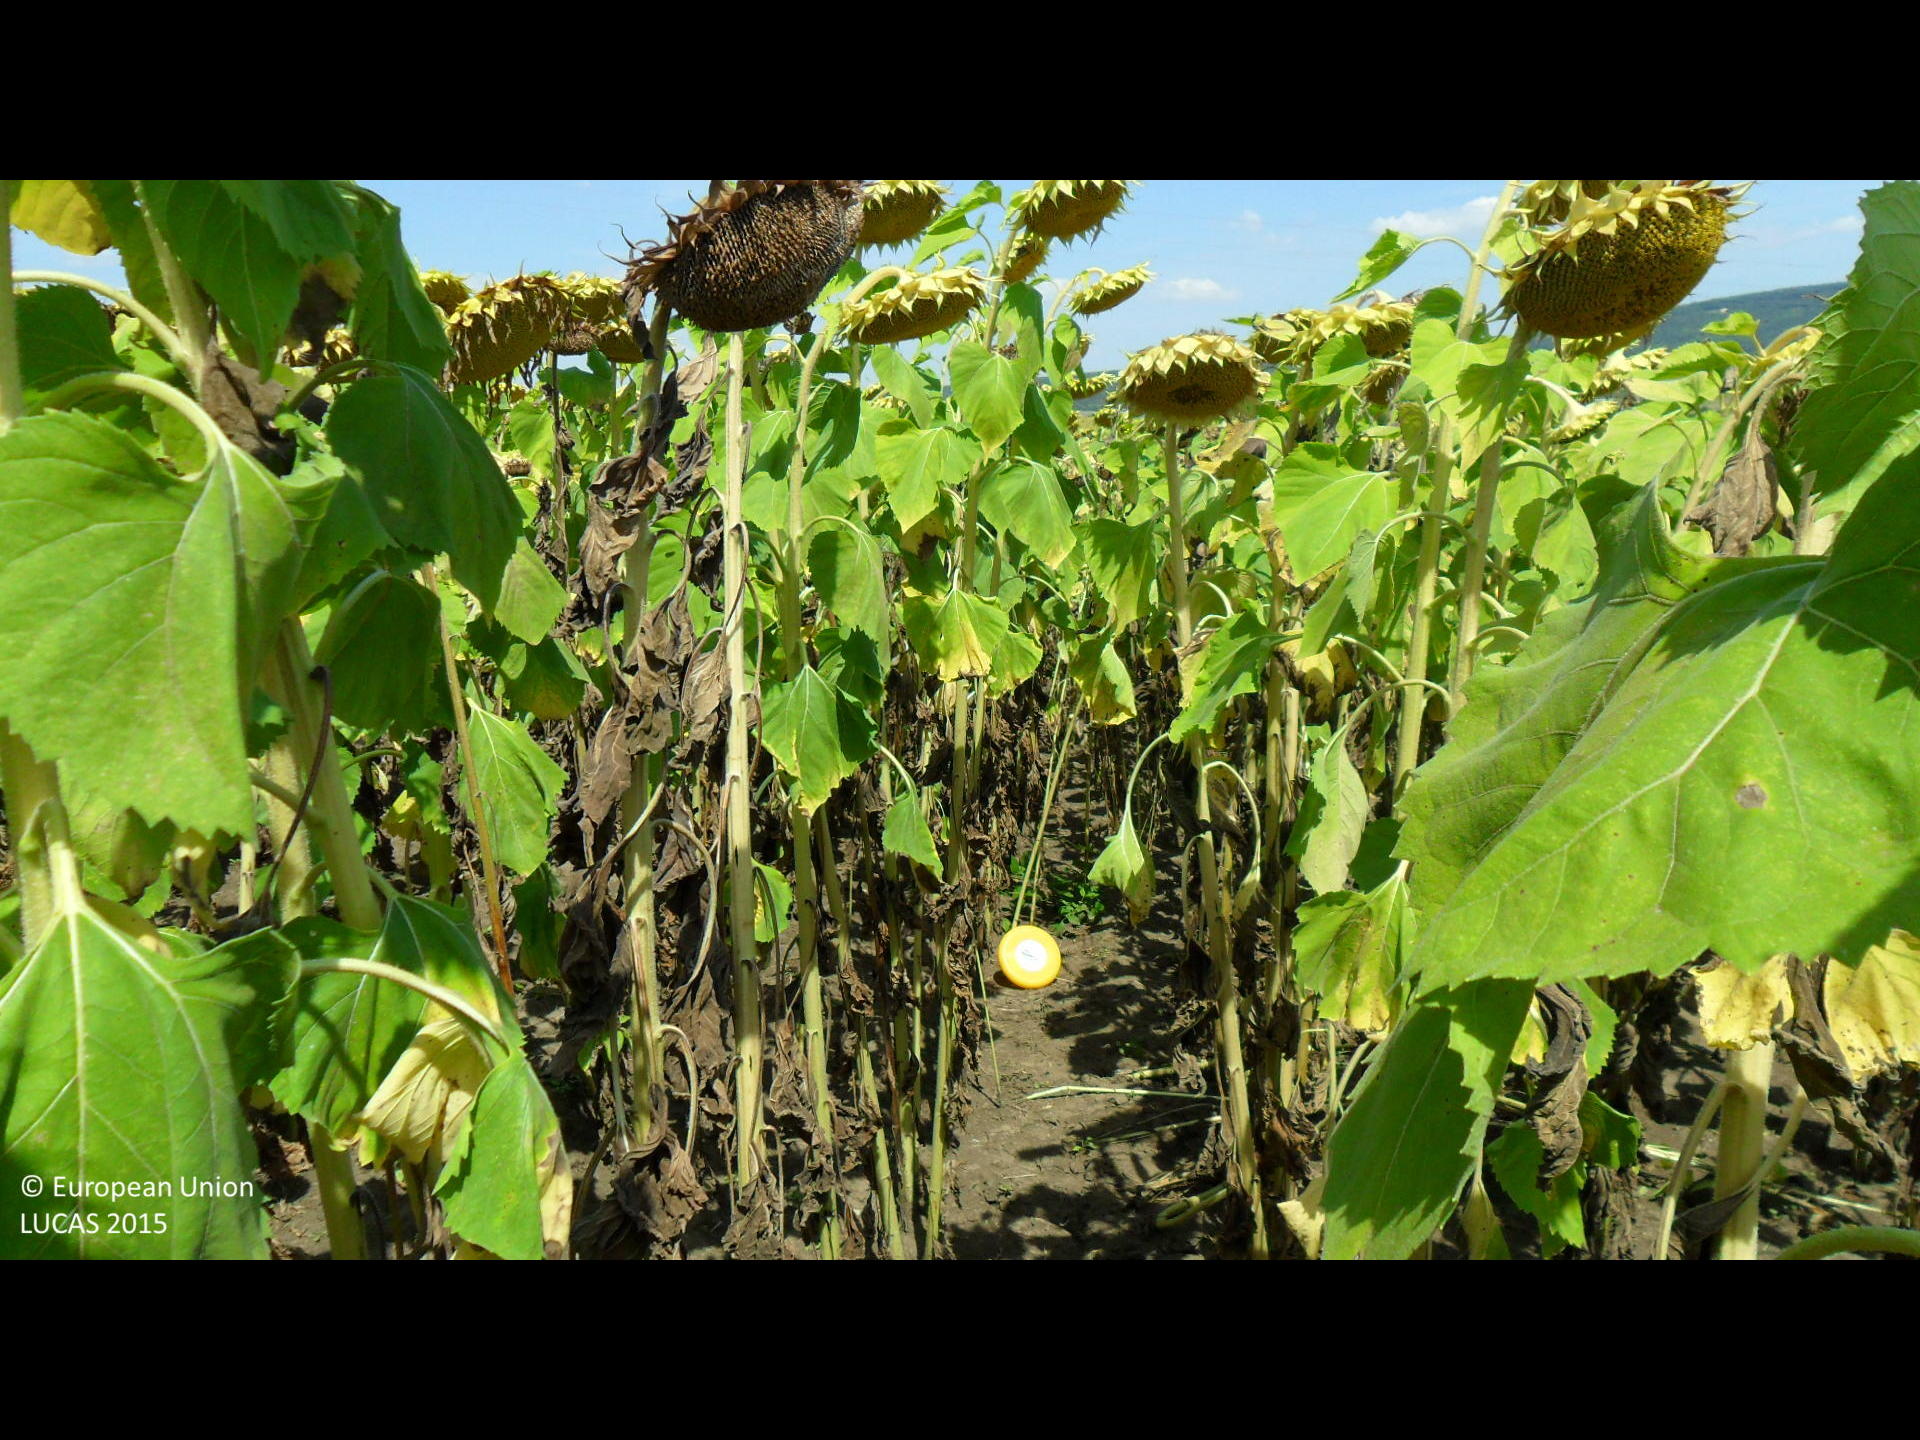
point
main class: Cropland
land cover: Sunflower
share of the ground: > 75 %
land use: Agriculture (excluding fallow land and kitchen gardens)
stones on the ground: < 10 %
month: August
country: BG
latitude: 43.3751
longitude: 26.4553
